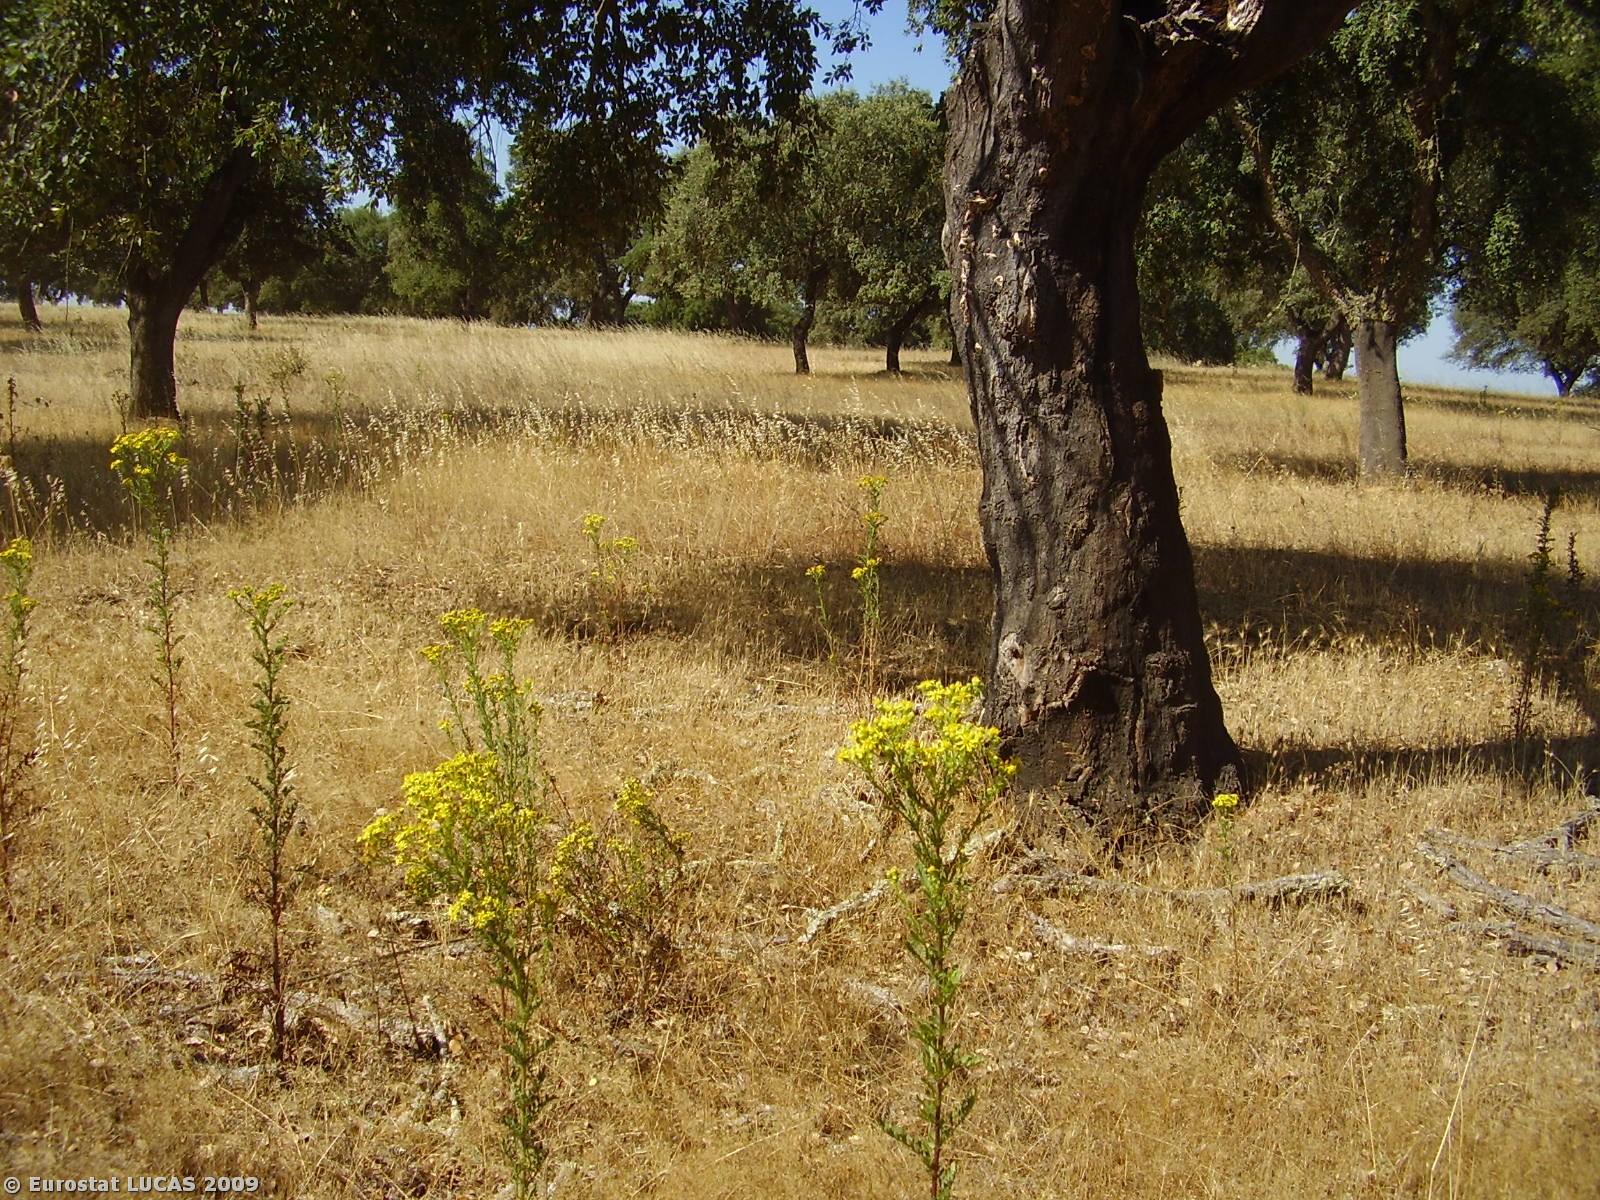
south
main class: Woodland
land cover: Broadleaved woodland
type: broadleaved evergreen forest
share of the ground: 25 - 50 %
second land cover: Spontaneously vegetated surfaces
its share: 50 - 75 %
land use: Forestry
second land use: Fallow land
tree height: > 5 m
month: July
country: PT
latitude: 38.7605
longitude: -7.9624
